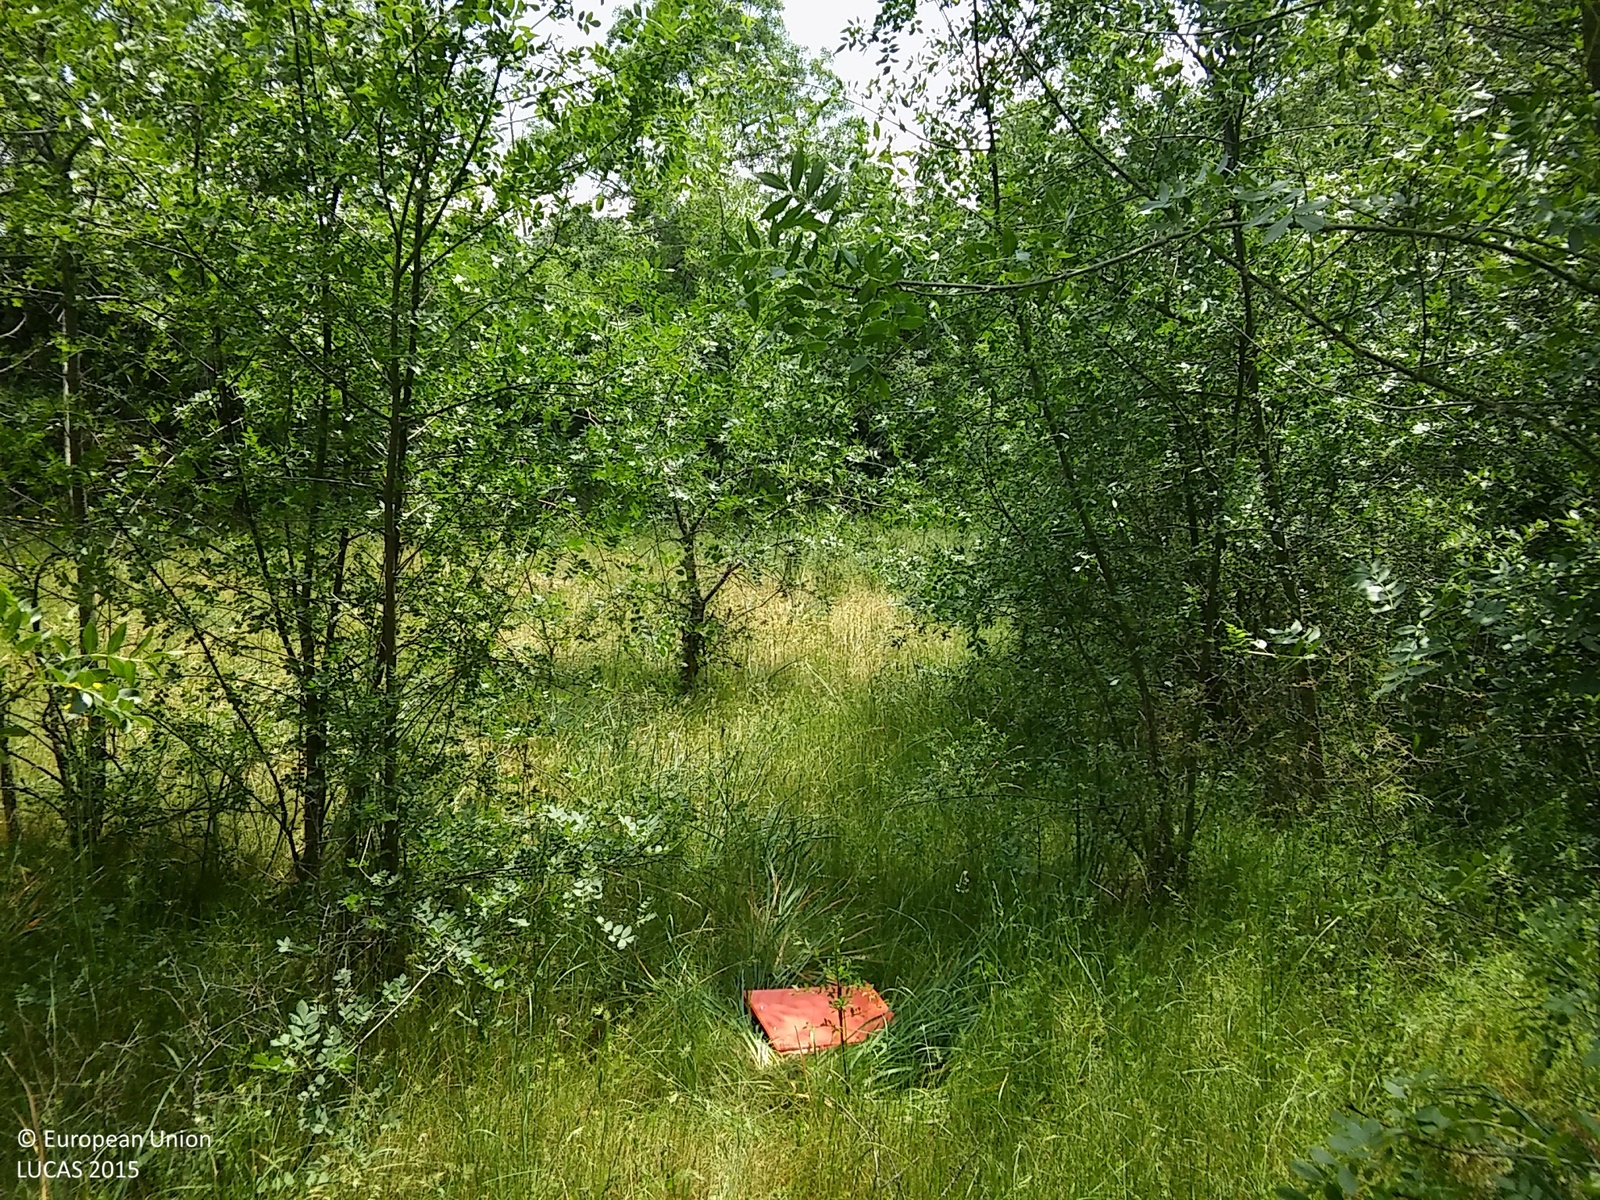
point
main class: Woodland
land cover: Broadleaved woodland
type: non-riverine alder, birch or aspen forest
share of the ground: 25 - 50 %
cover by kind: herbaceous plants 60 %, broadleaved forest trees 25 %, shrubs 15 %
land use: Abandoned areas
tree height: > 5 m
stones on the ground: < 10 %
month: June
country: ES
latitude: 41.1490
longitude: -3.7138
